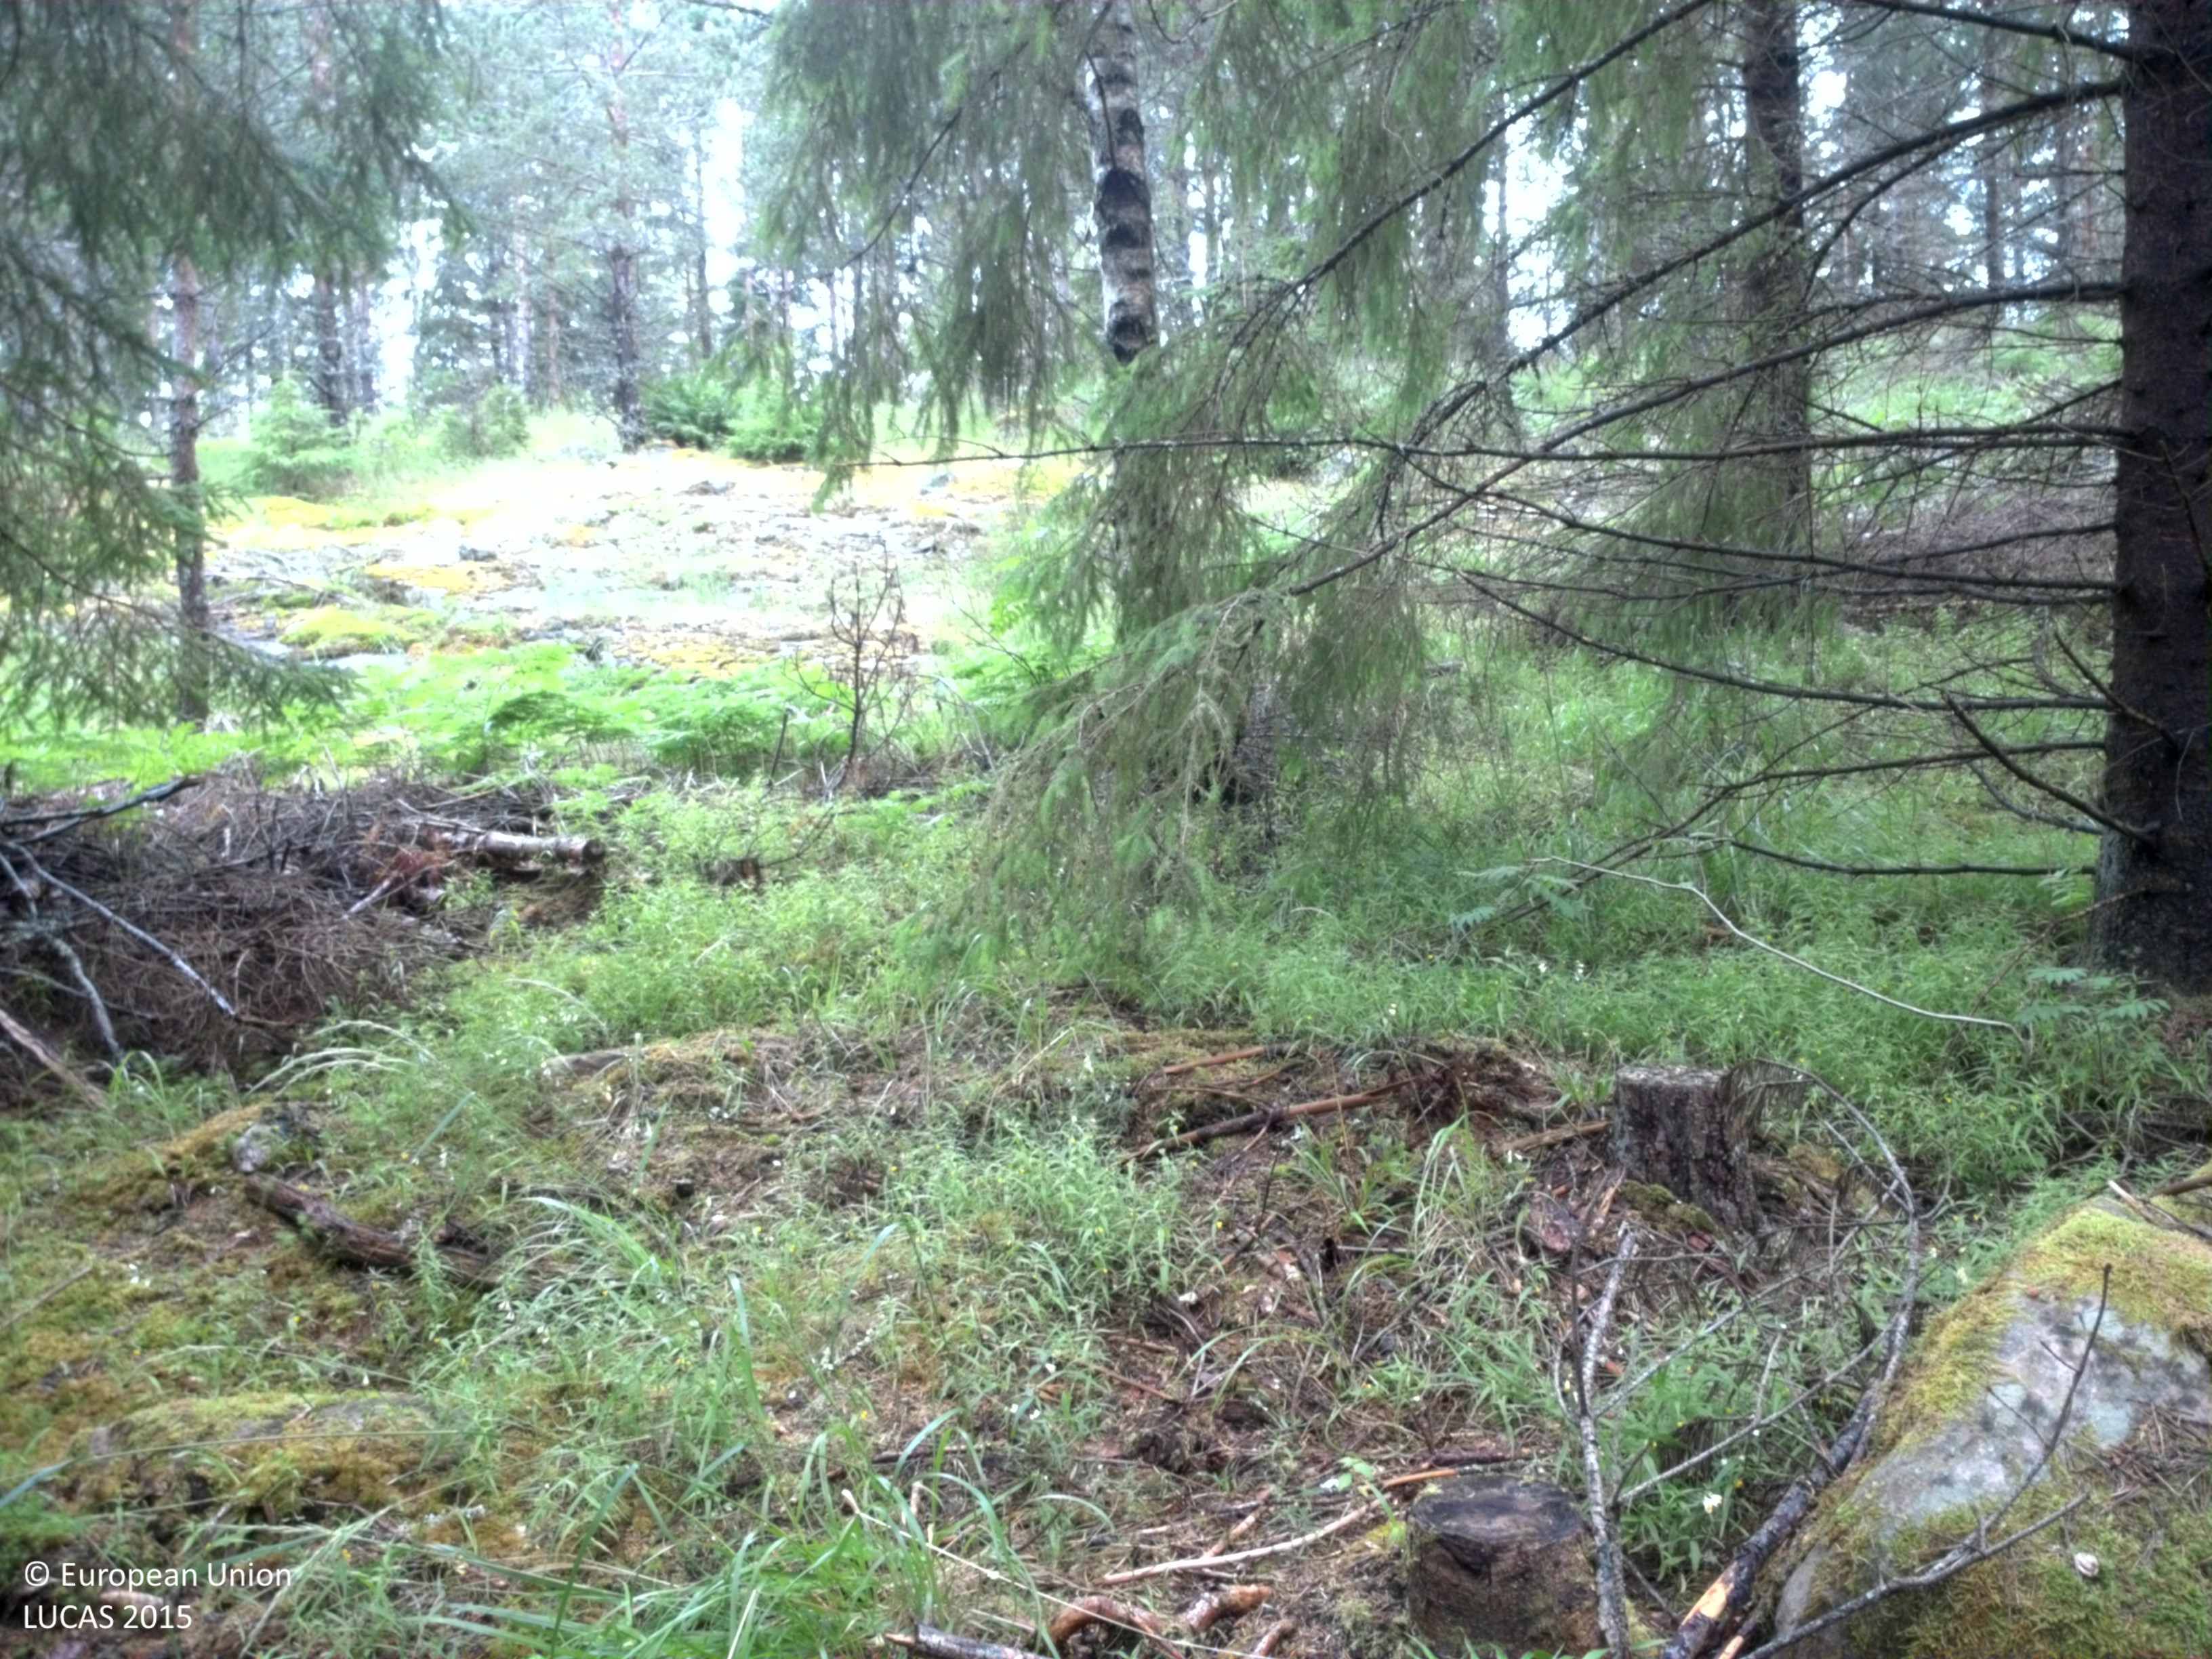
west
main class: Woodland
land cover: Spruce dominated coniferous woodland
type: boreal forest
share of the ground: 50 - 75 %
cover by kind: coniferous forest trees 65 %, lichens and mosses 30 %, herbaceous plants 5 %
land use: Forestry
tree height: > 5 m
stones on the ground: 25 - 50 %
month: July
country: SE
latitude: 59.2420
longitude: 12.3959
